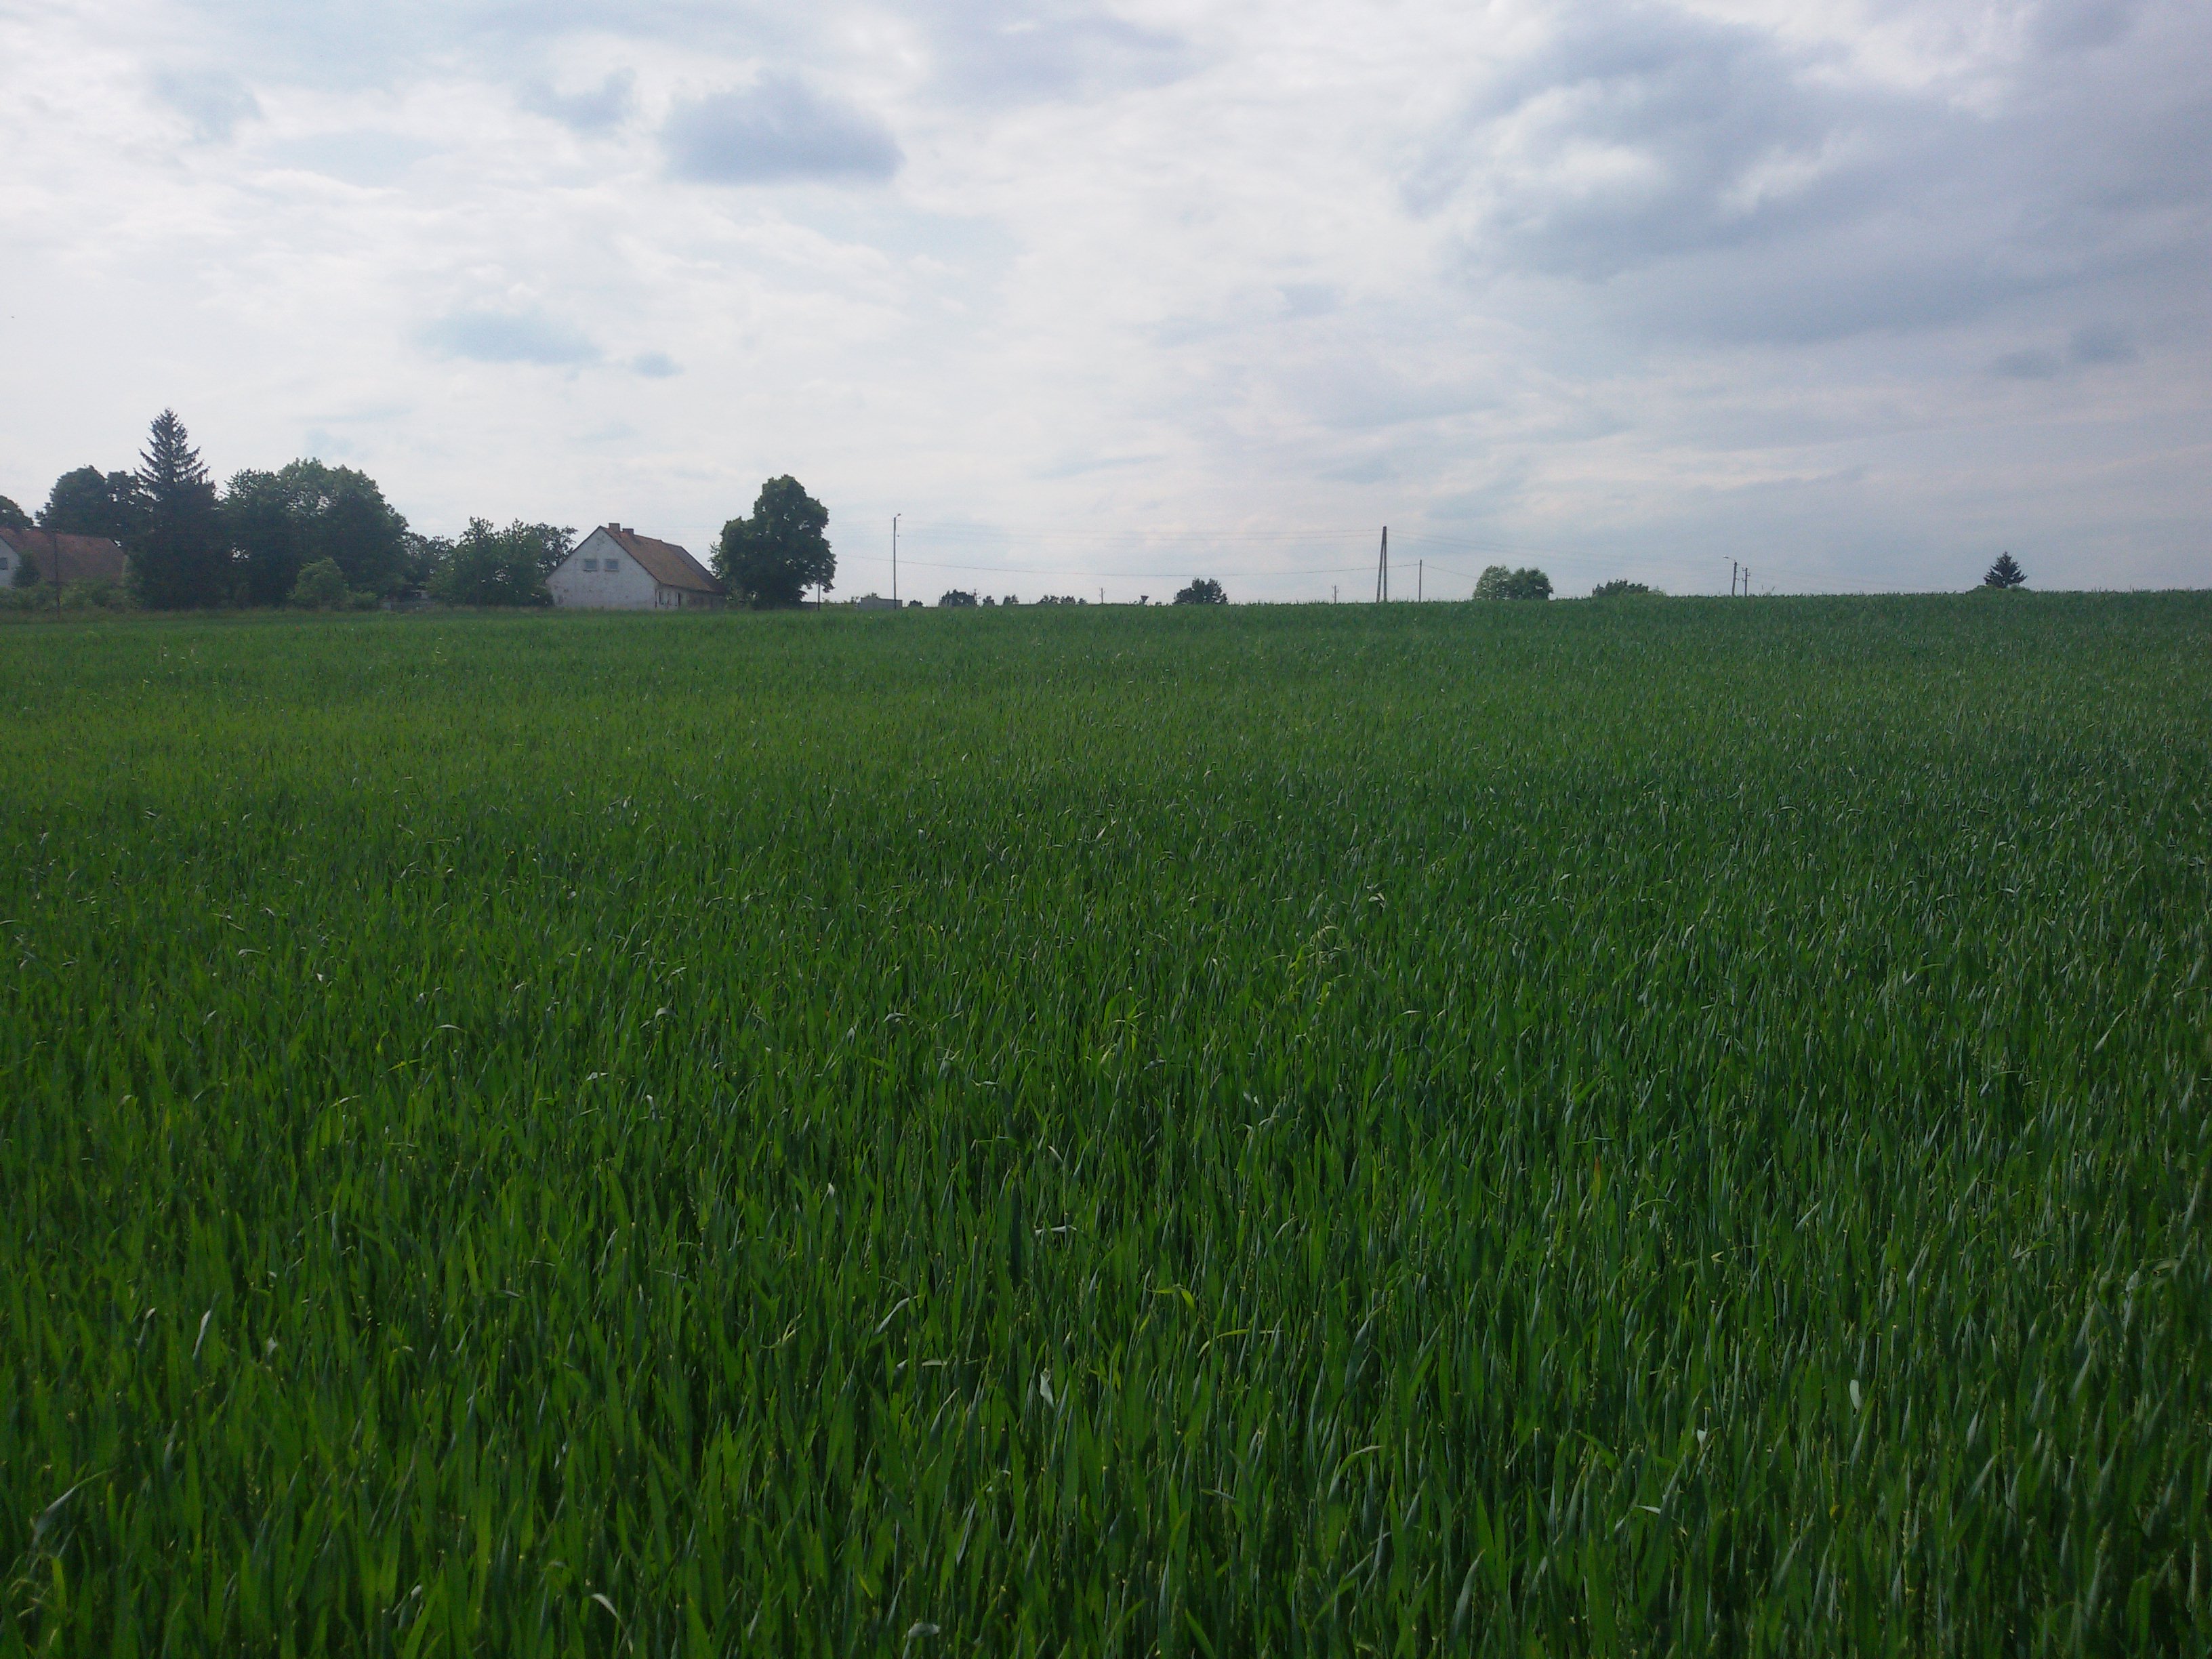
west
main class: Cropland
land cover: Common wheat
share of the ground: > 75 %
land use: Agriculture (excluding fallow land and kitchen gardens)
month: May
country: PL
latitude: 50.5347
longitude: 17.1923
